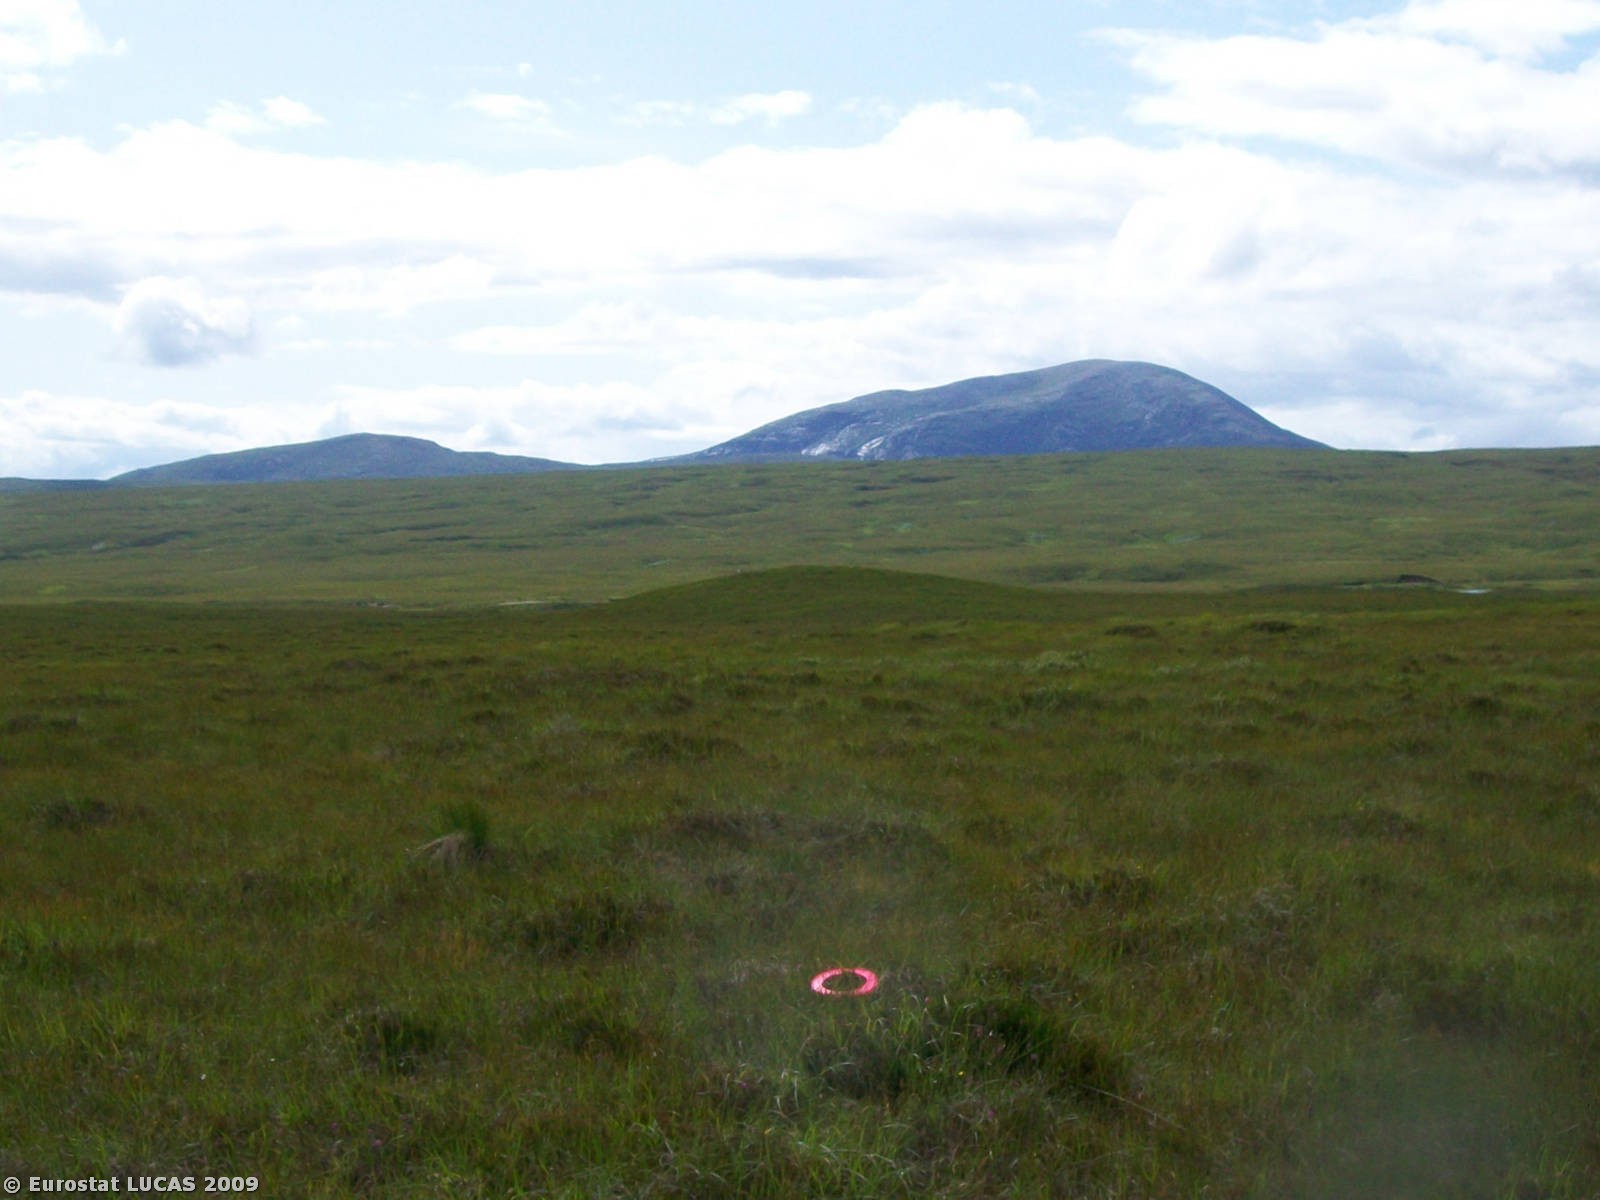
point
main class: Shrubland
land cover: Shrubland without tree cover
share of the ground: > 75 %
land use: Fallow land
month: July
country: GB
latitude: 58.3200
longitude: -4.5471
